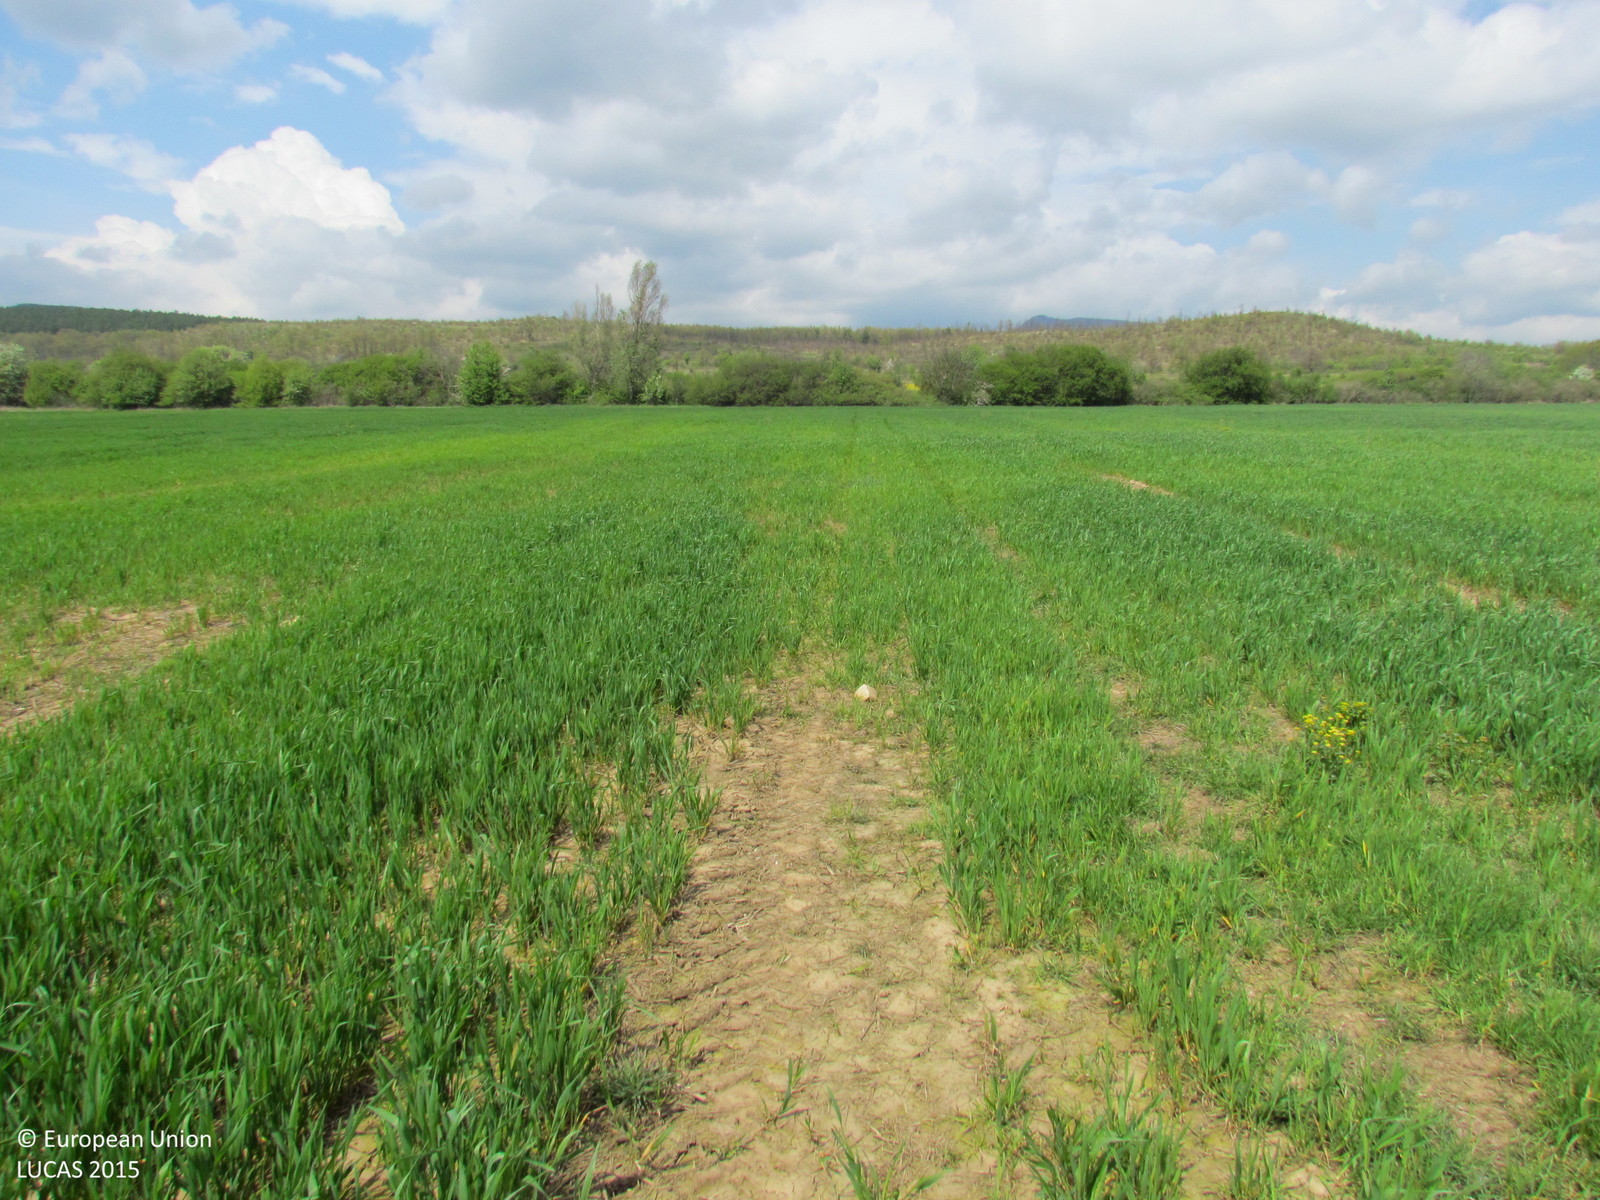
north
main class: Cropland
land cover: Barley
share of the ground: > 75 %
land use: Agriculture (excluding fallow land and kitchen gardens)
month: April
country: BG
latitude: 42.8457
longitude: 26.6560
